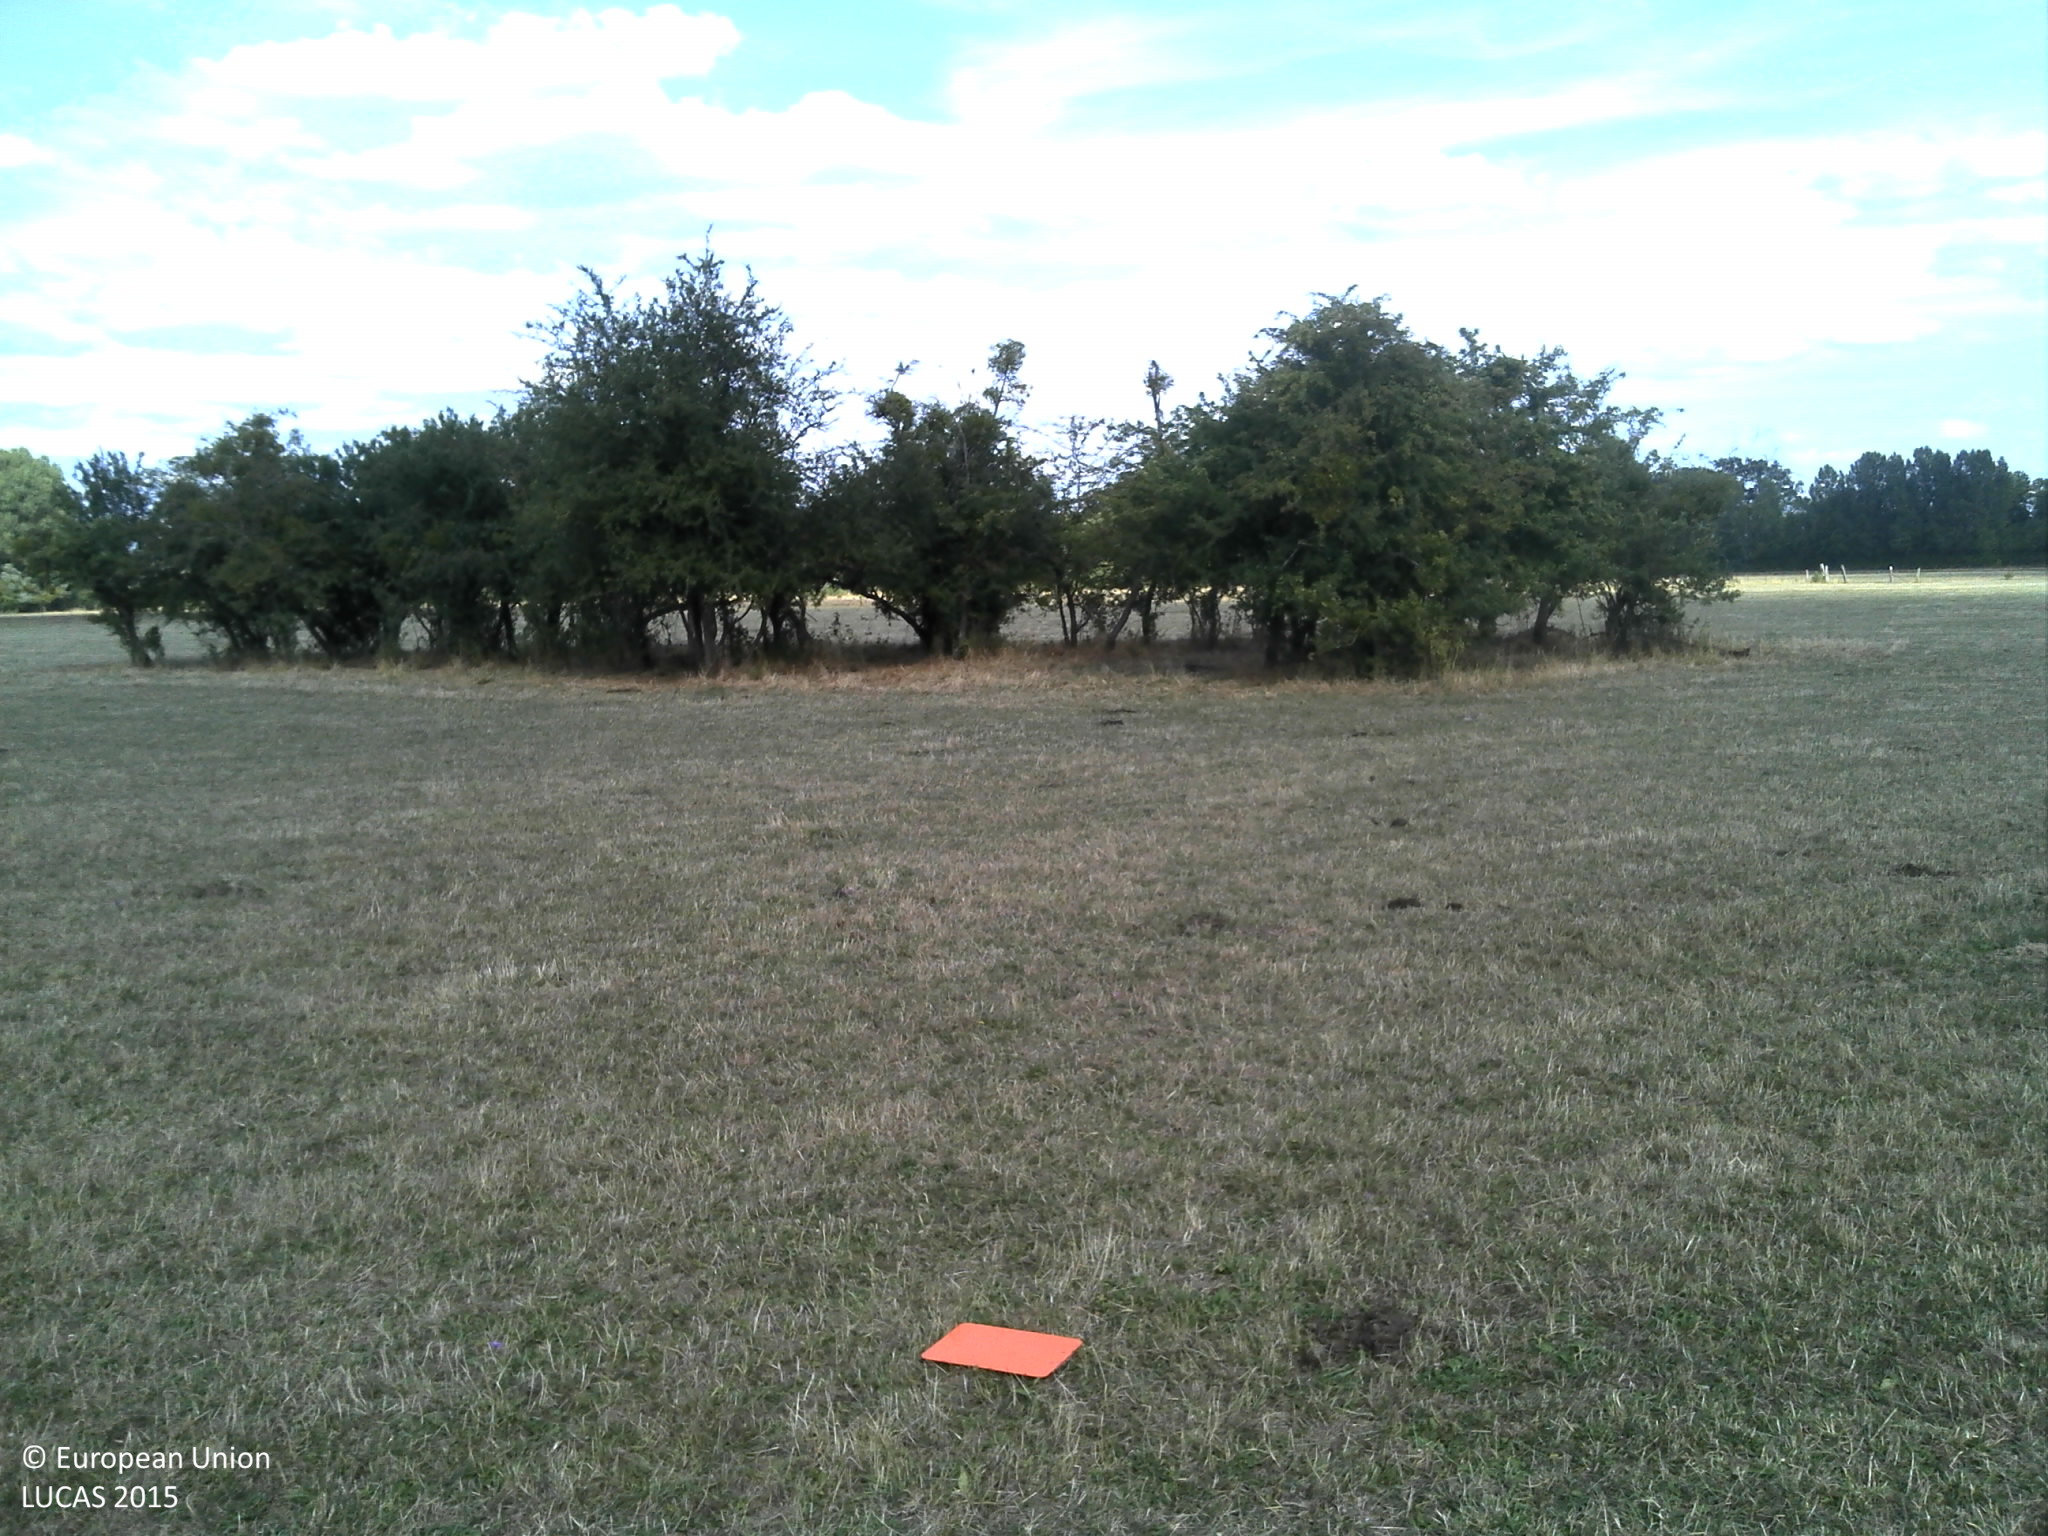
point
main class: Grassland
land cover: Grassland without tree/shrub cover
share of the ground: > 75 %
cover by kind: herbaceous plants 100 %
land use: Agriculture (excluding fallow land and kitchen gardens)
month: July
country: FR
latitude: 49.4921
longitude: 4.4877
